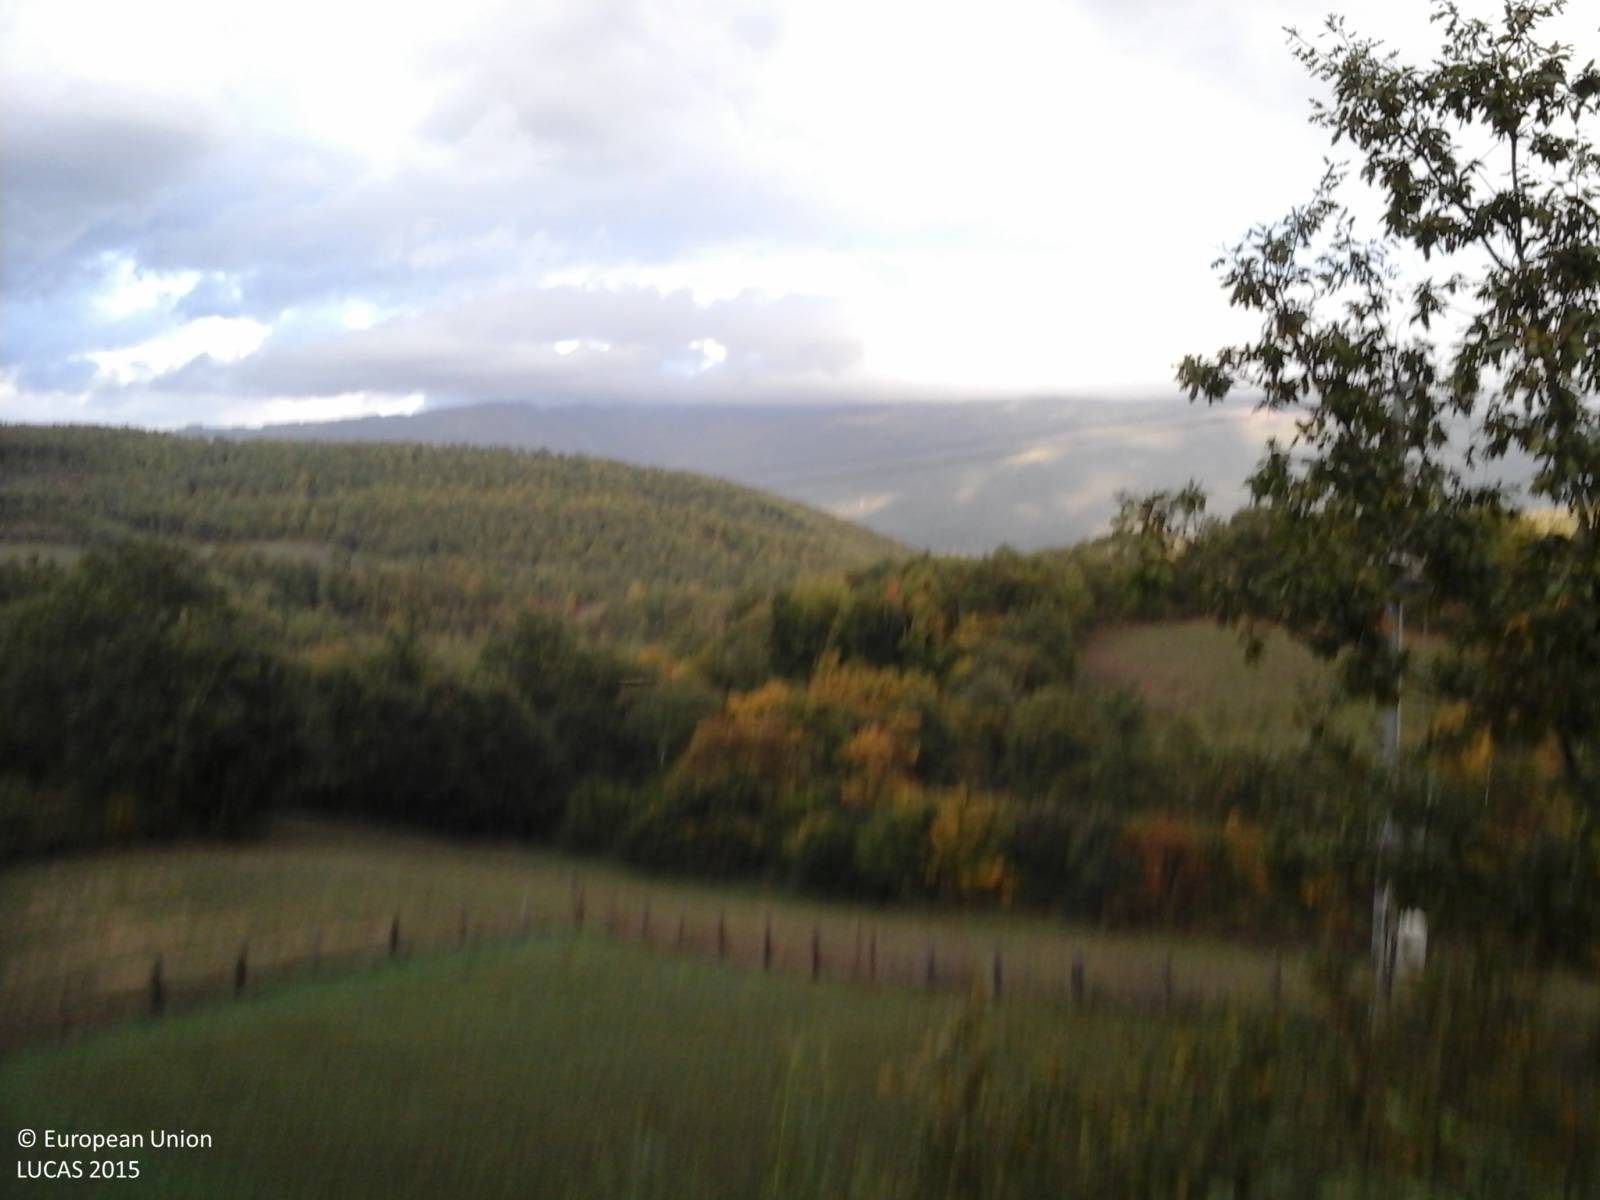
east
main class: Woodland
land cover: Broadleaved woodland
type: thermophilous deciduous forest
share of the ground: > 75 %
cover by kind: broadleaved forest trees 100 %
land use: Forestry
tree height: > 5 m
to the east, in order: Broadleaved woodland; Tracks; Broadleaved woodland
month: October
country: IT
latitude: 42.6562
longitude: 13.2472
